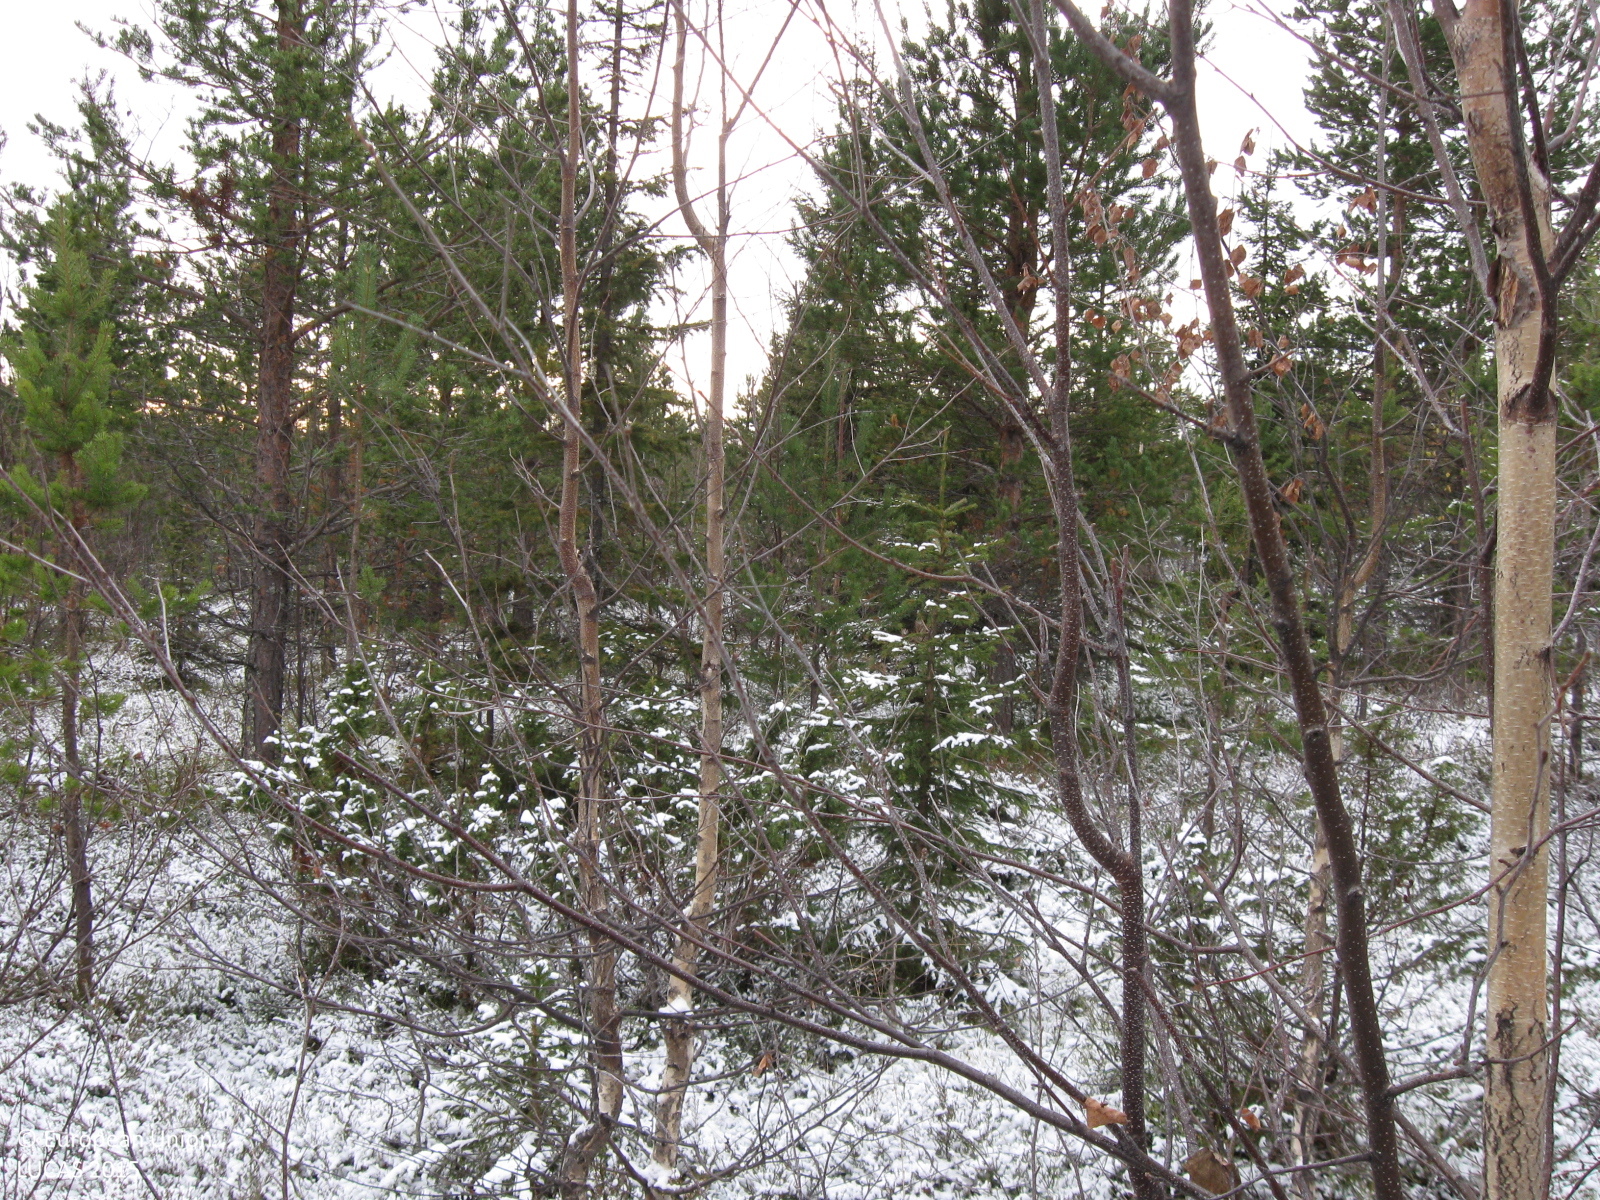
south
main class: Woodland
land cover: Pine dominated mixed woodland
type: boreal forest
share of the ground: 50 - 75 %
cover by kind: broadleaved forest trees 40 %, shrubs 25 %, coniferous forest trees 15 %, herbaceous plants 10 %, lichens and mosses 5 %, unconsolidated bare surface 5 %
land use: Forestry
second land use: Amenities, museums, leisure
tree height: < 5 m
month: October
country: SE
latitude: 66.2629
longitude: 21.5647
